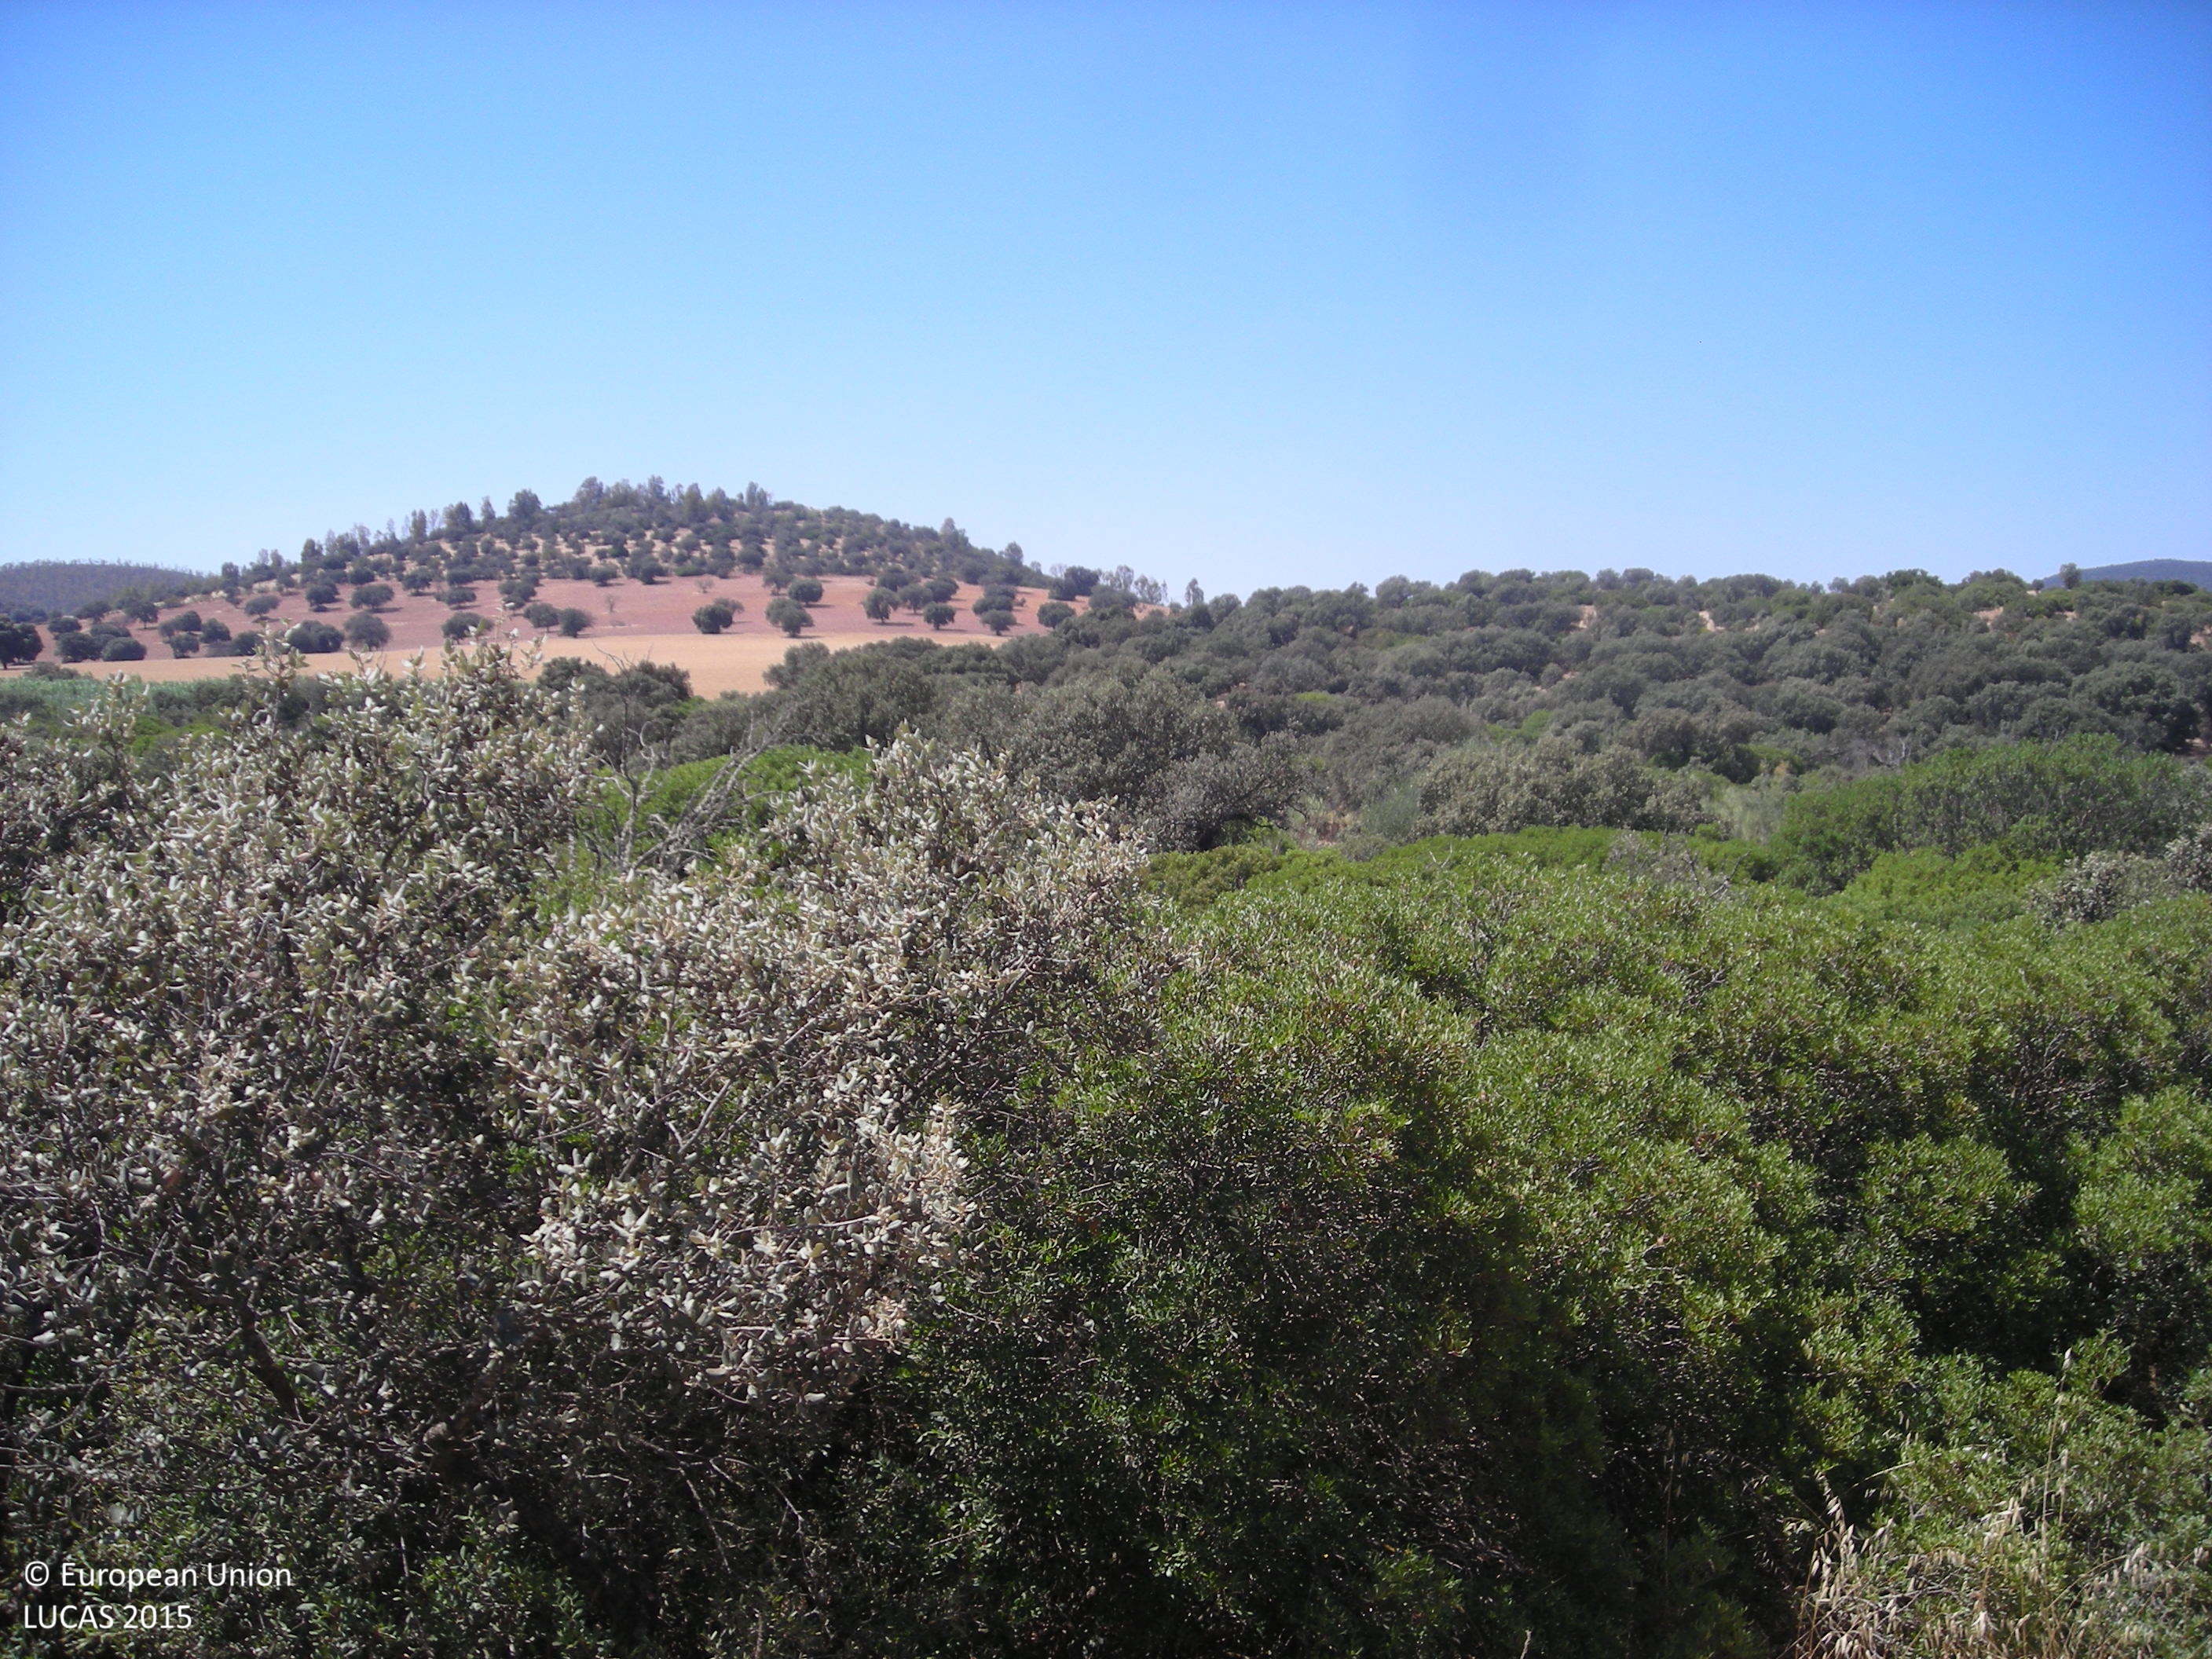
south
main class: Grassland
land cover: Grassland without tree/shrub cover
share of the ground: > 75 %
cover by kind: herbaceous plants 100 %
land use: Agriculture (excluding fallow land and kitchen gardens)
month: July
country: ES
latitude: 38.7740
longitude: -5.9198
